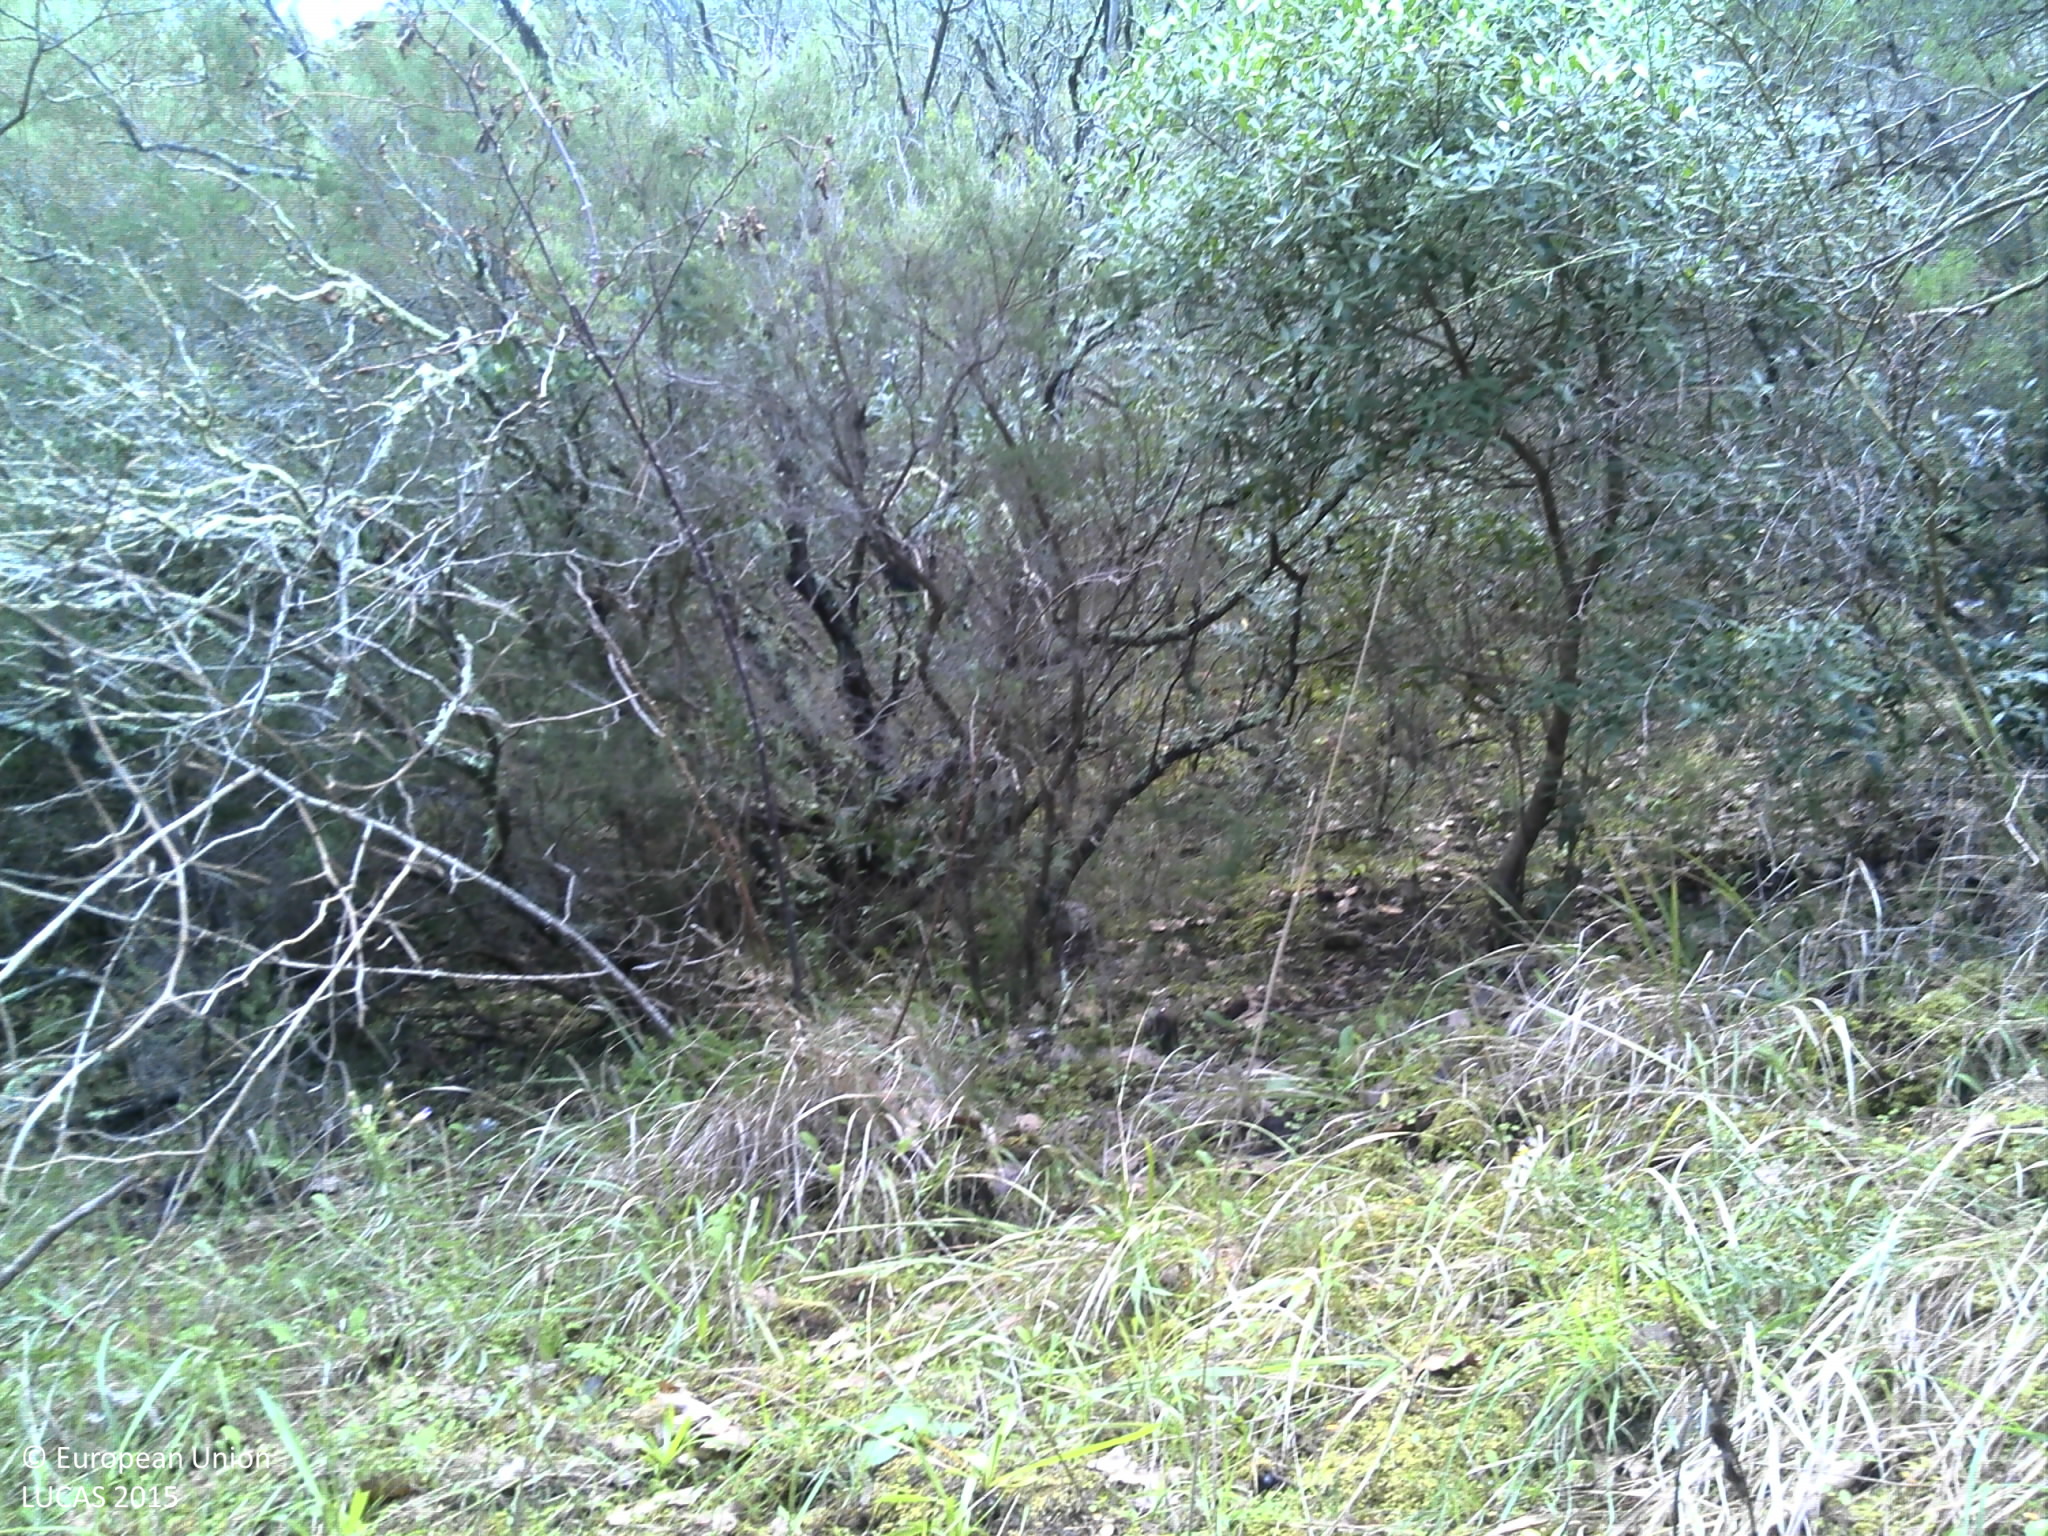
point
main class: Woodland
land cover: Pine dominated mixed woodland
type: broadleaved evergreen forest
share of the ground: > 75 %
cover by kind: broadleaved forest trees 50 %, coniferous forest trees 25 %, shrubs 25 %
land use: Semi-natural and natural areas not in use
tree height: > 5 m
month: October
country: FR
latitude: 43.1941
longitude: 6.6249
